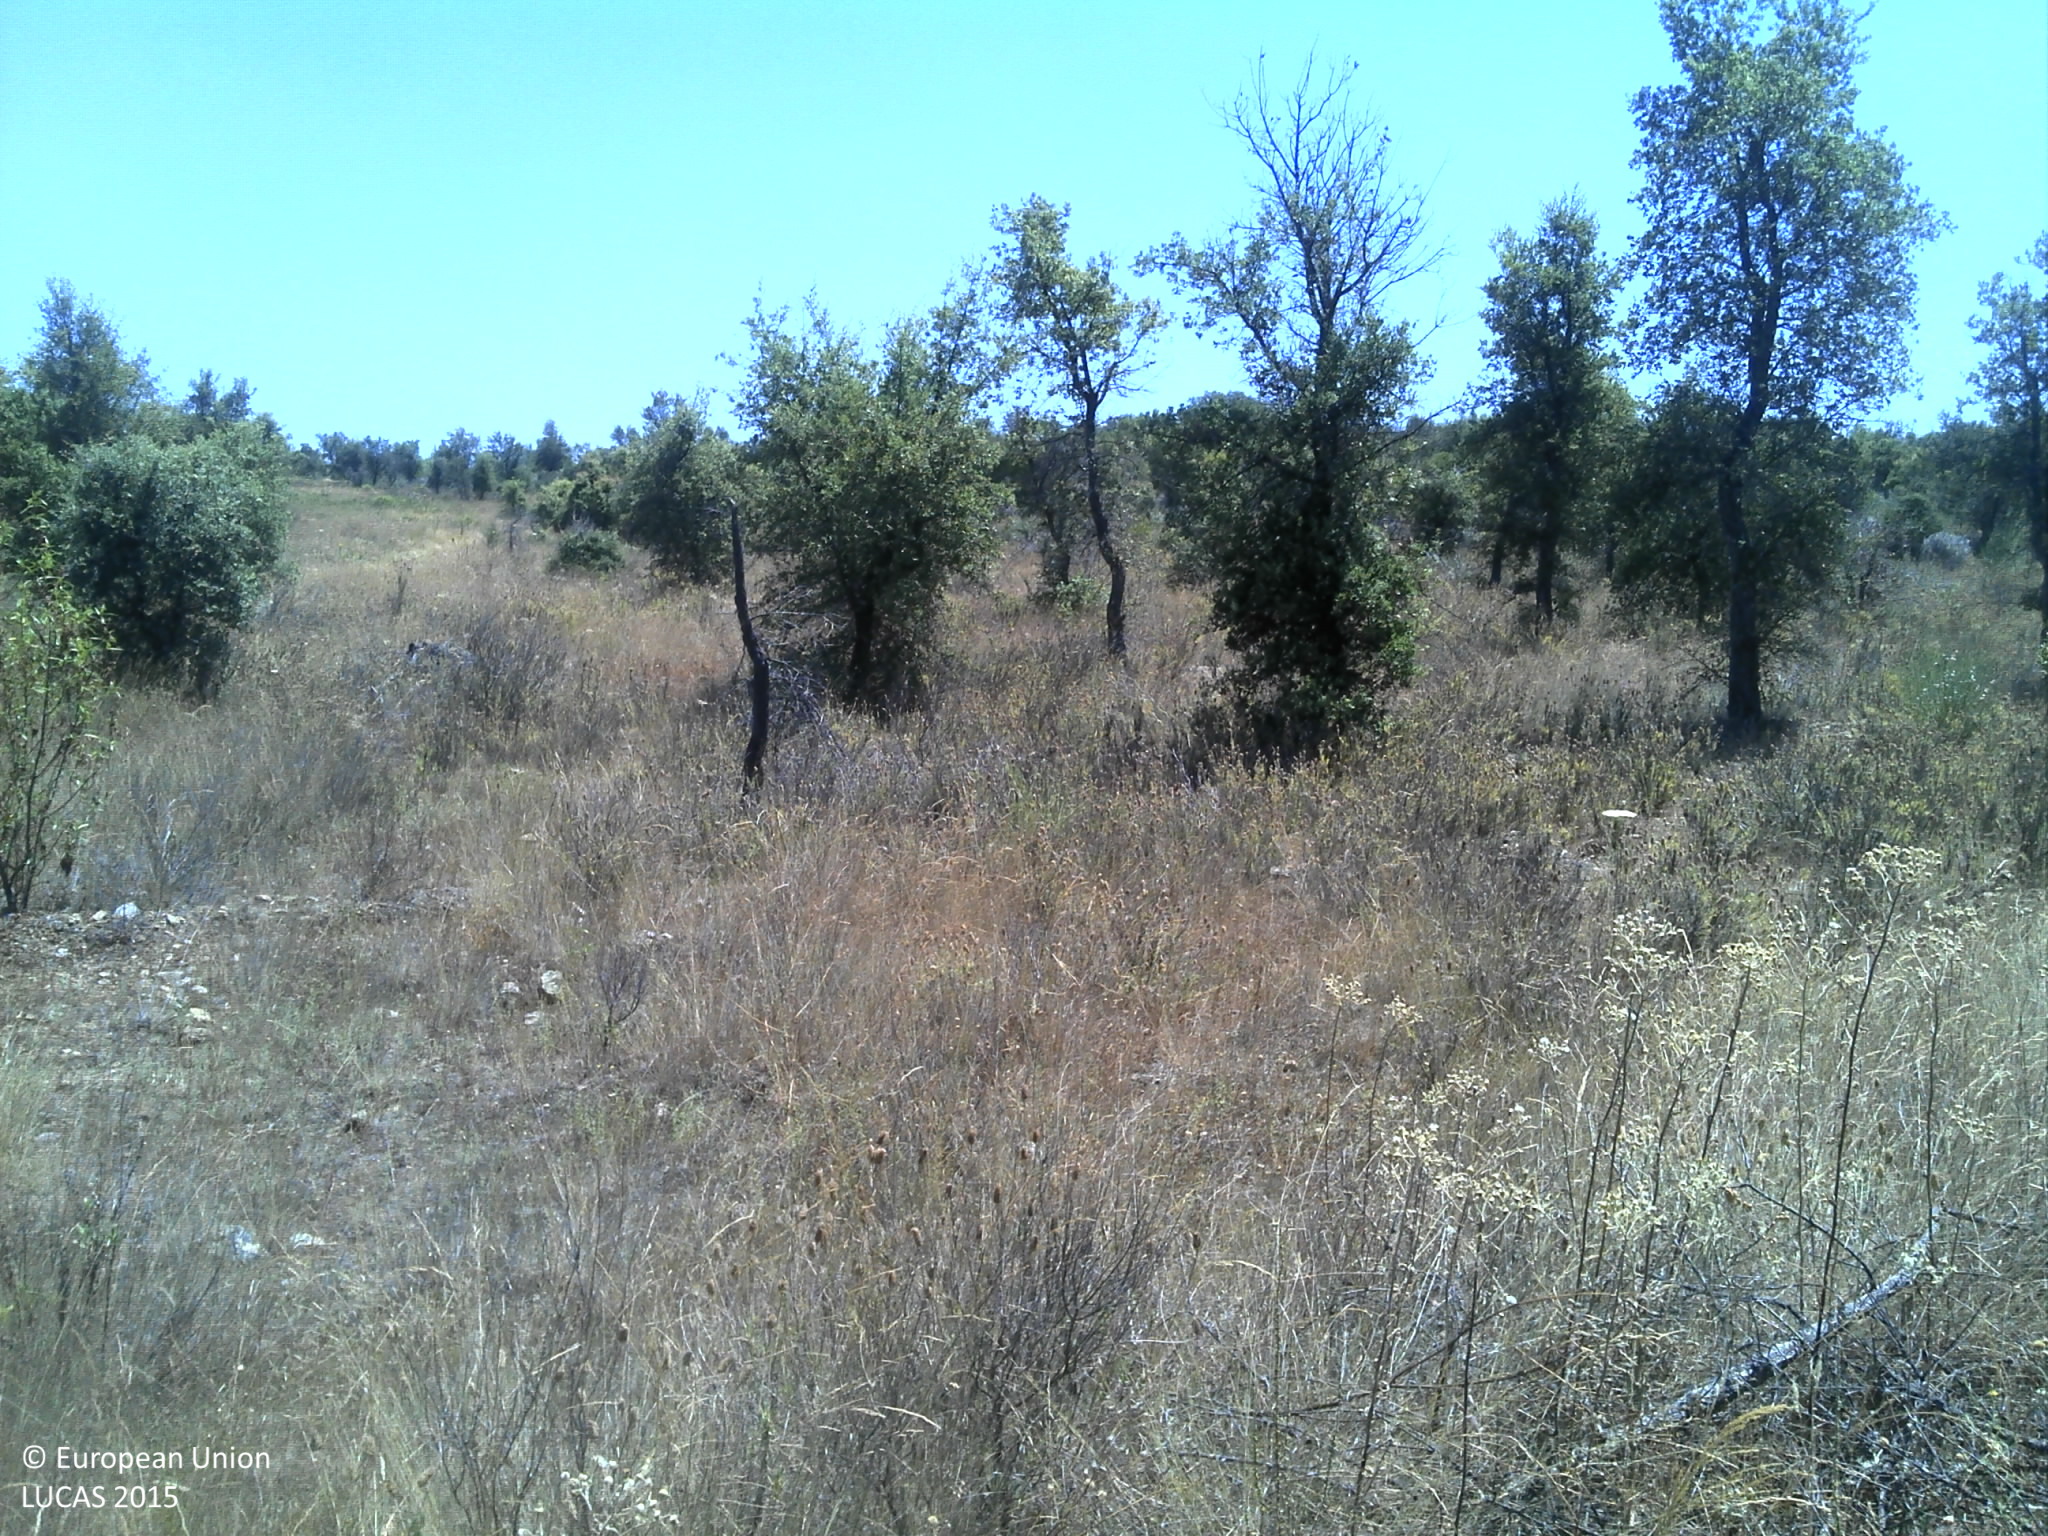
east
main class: Woodland
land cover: Broadleaved woodland
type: broadleaved evergreen forest
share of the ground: 25 - 50 %
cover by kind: broadleaved forest trees 45 %, herbaceous plants 20 %, unconsolidated bare surface 20 %, shrubs 15 %
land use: Forestry
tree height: < 5 m
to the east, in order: Broadleaved woodland; Tracks; Grass margins; Fences; Shruby margins; Broadleaved woodland
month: June
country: PT
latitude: 40.0903
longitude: -7.2572
